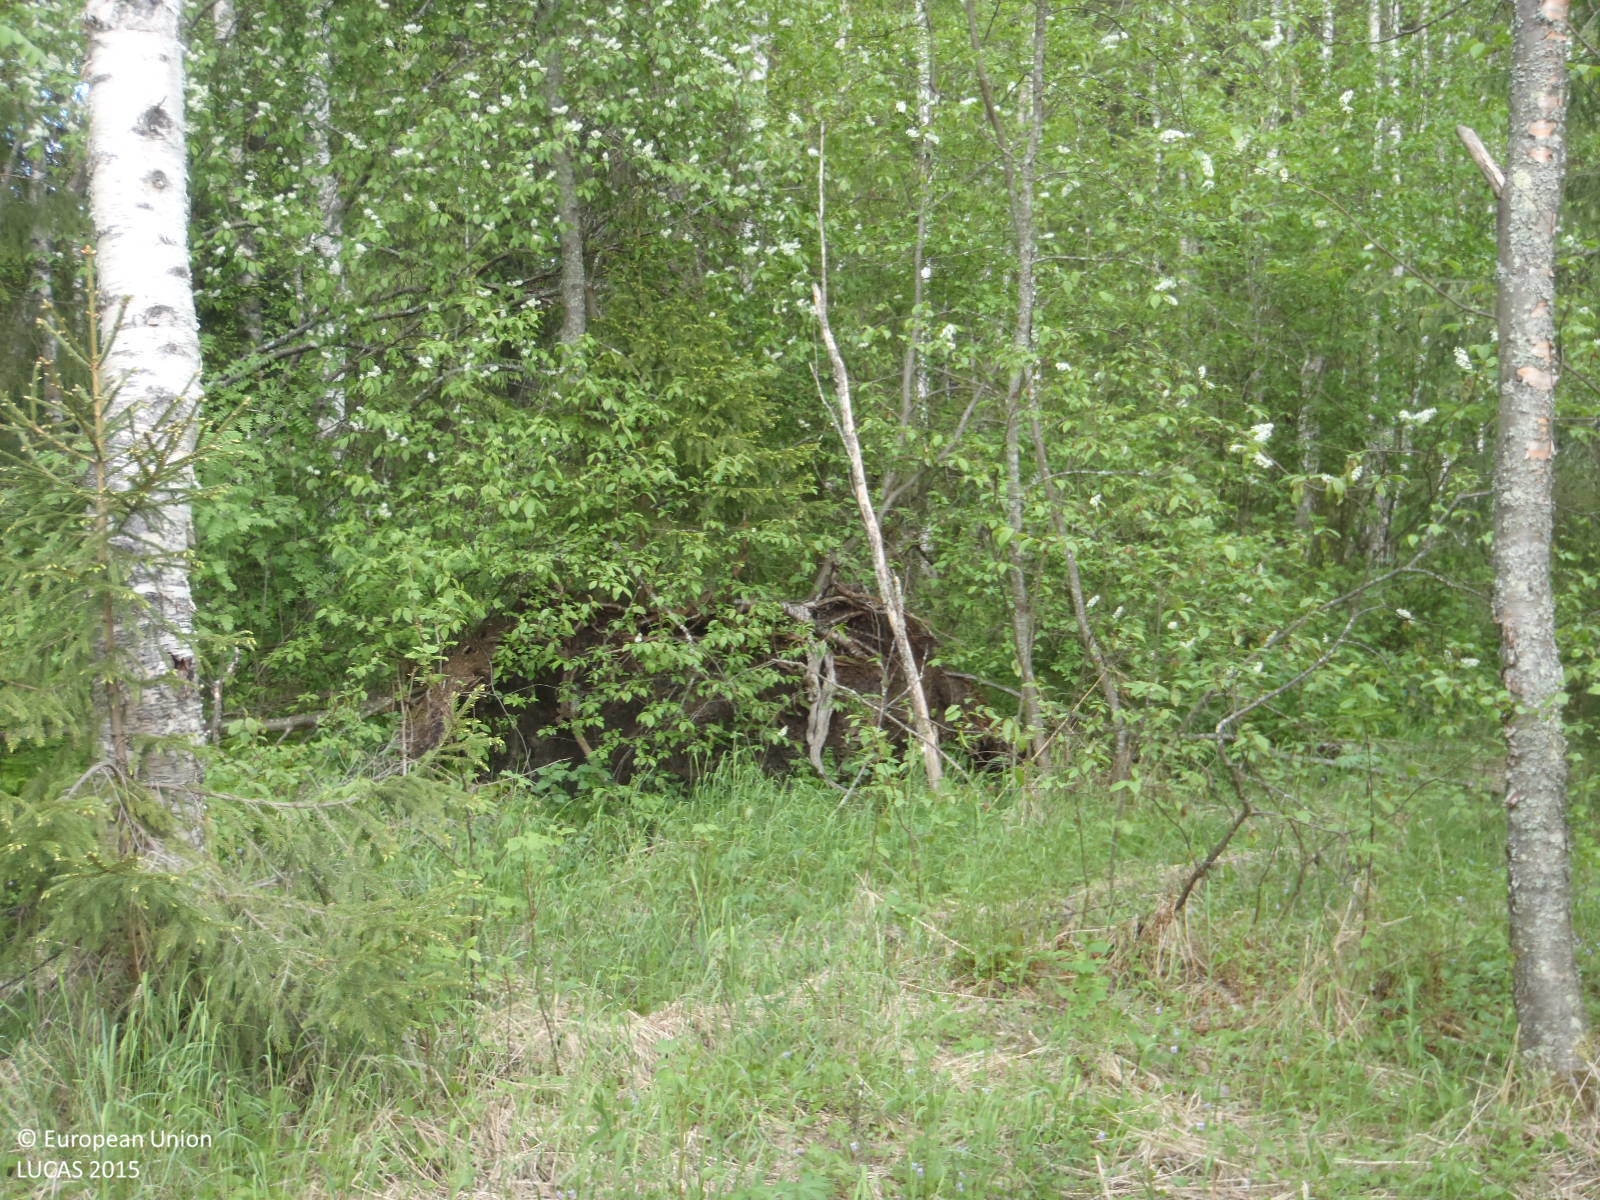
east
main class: Woodland
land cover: Other mixed woodland
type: boreal forest
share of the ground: > 75 %
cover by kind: broadleaved forest trees 40 %, coniferous forest trees 35 %, shrubs 20 %, herbaceous plants 5 %
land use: Forestry
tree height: > 5 m
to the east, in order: Other mixed woodland; Broadleaved woodland; Spruce dominated coniferous woodland; Other mixed woodland; Ditches and canals; Other mixed woodland
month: June
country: FI
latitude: 64.9553
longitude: 25.5620
